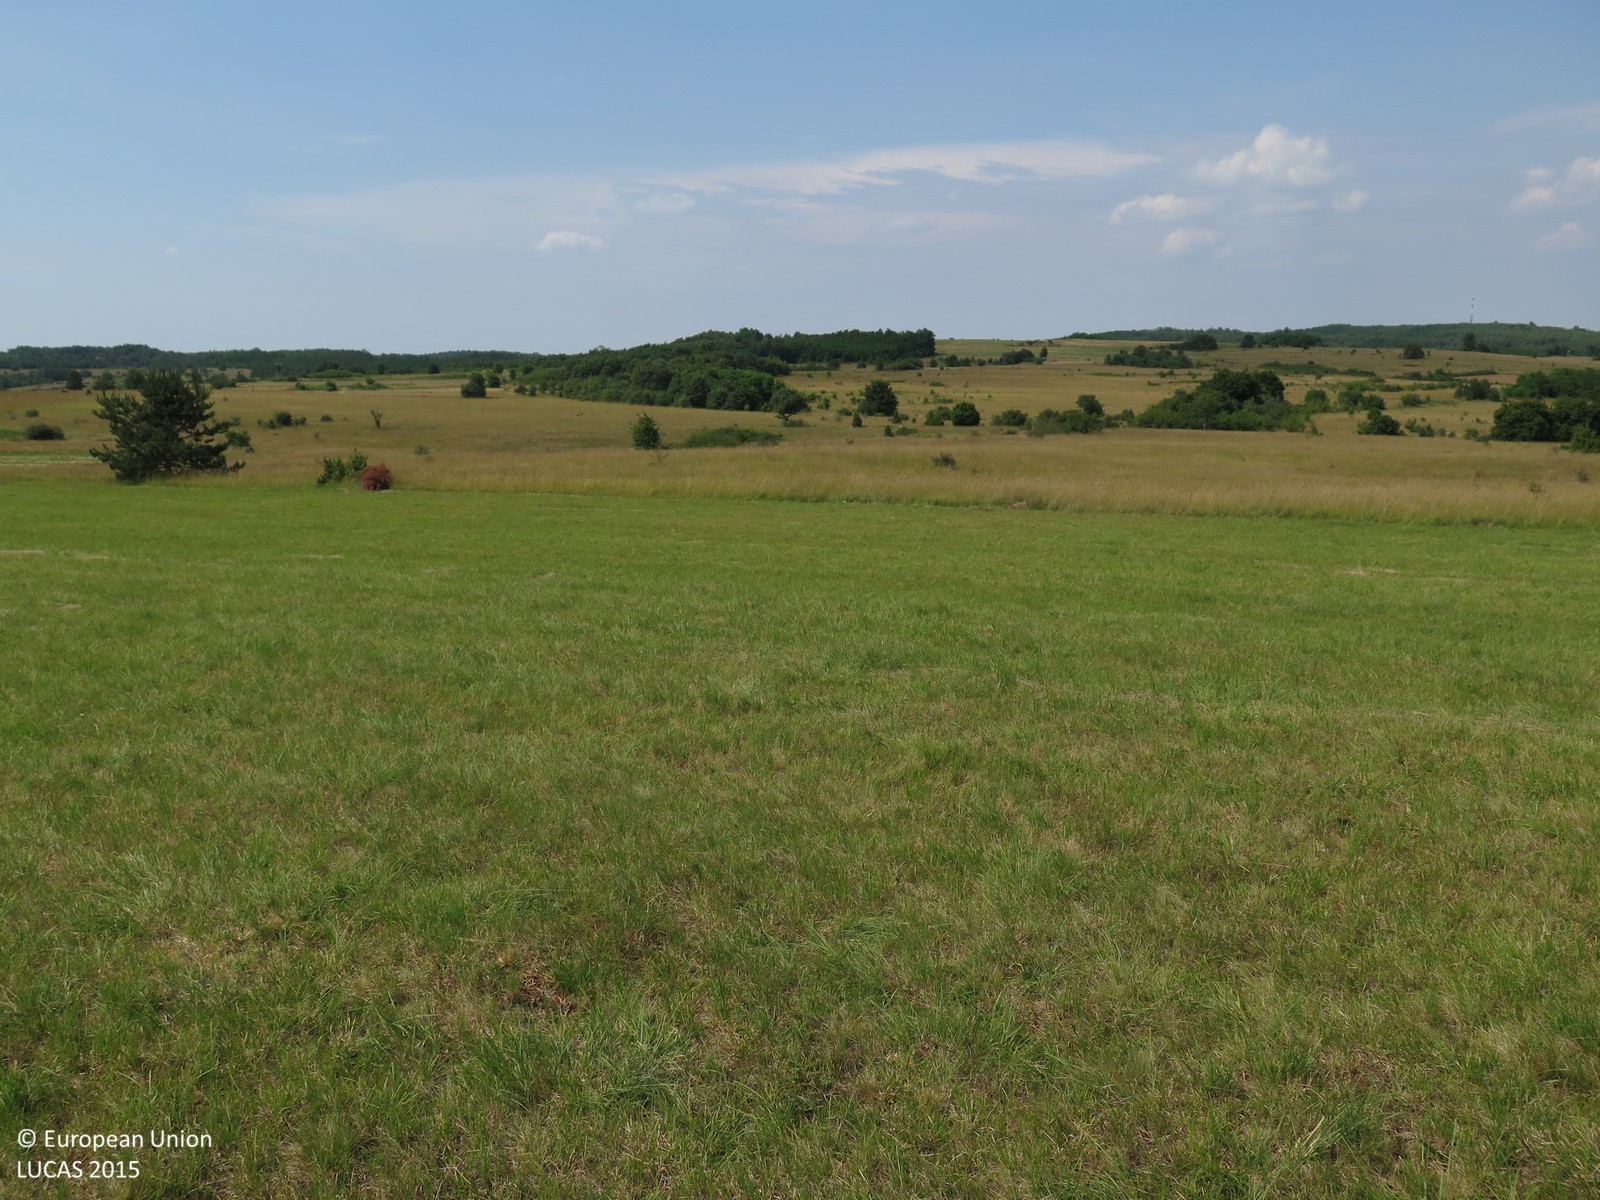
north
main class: Grassland
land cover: Grassland without tree/shrub cover
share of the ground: > 75 %
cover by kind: herbaceous plants 100 %
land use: Agriculture (excluding fallow land and kitchen gardens)
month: June
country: HR
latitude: 45.2734
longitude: 13.8061
